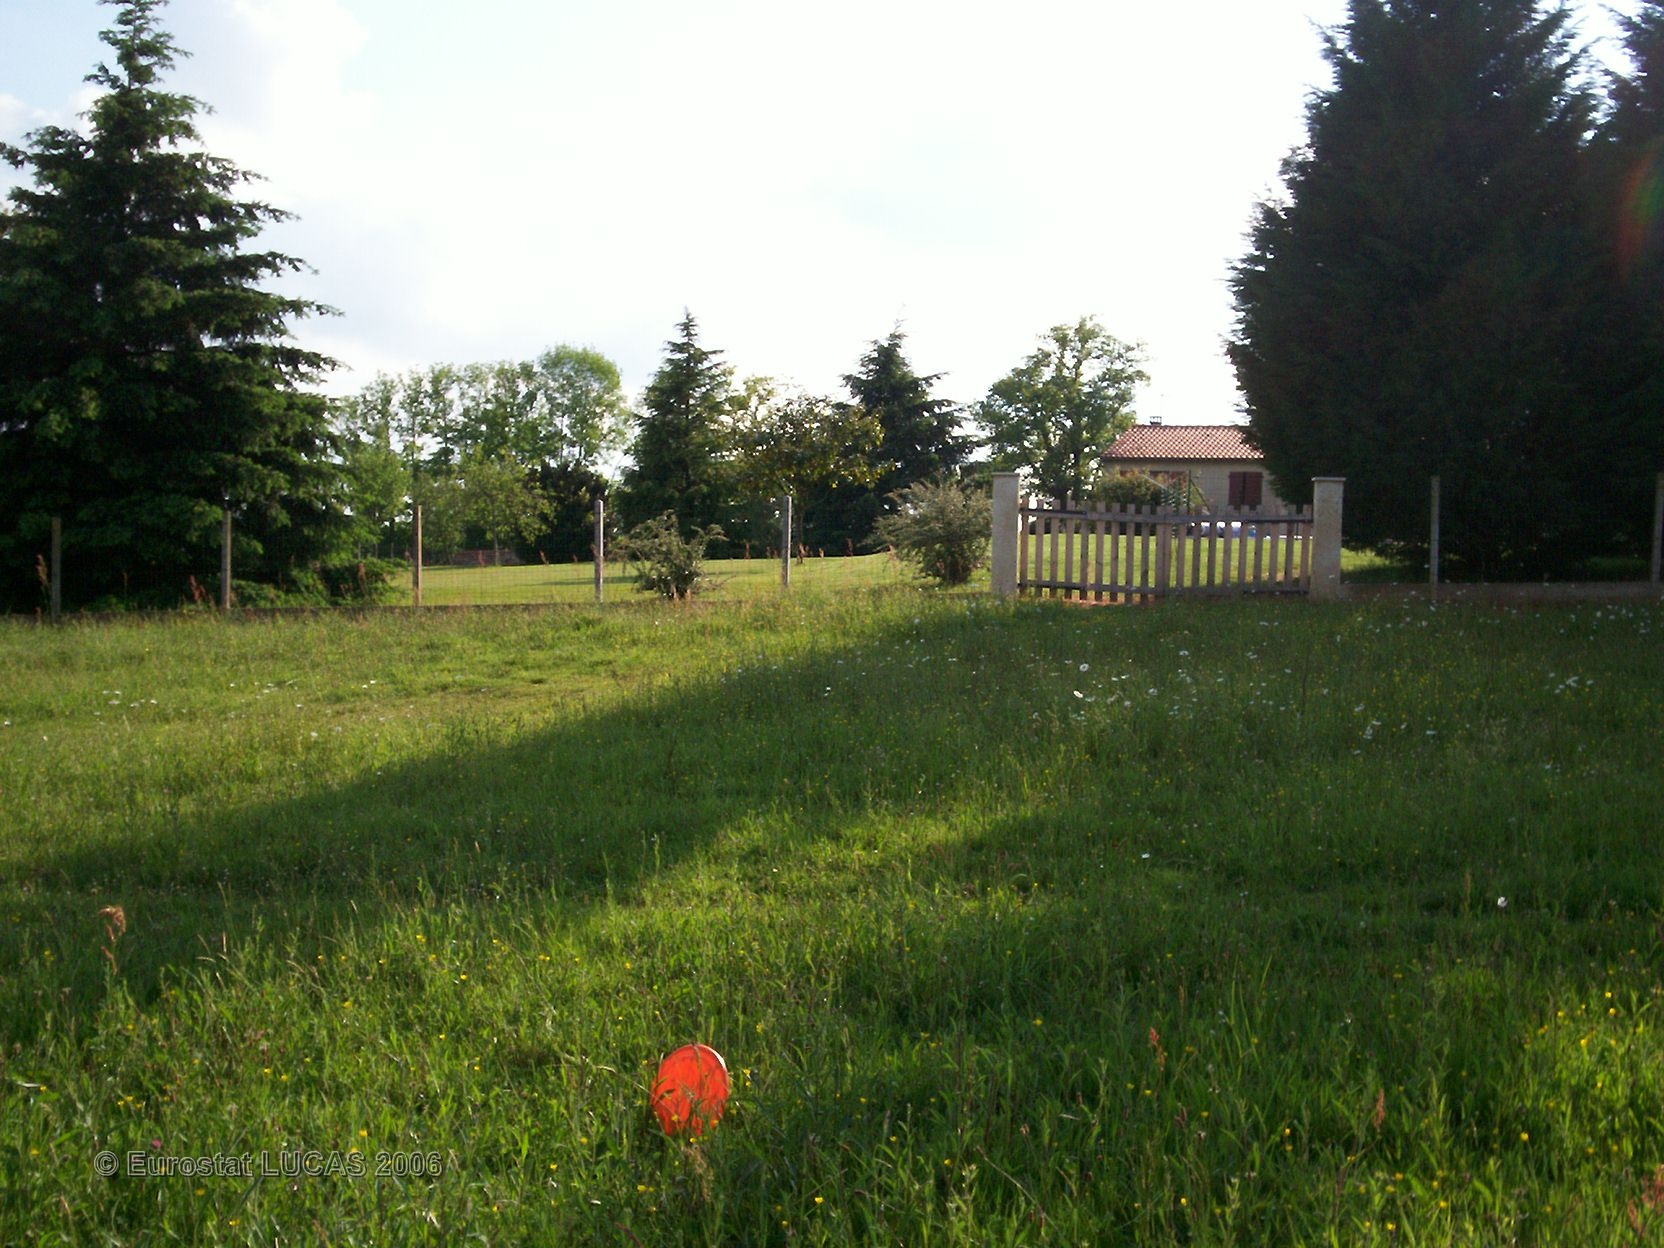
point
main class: Grassland
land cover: Grassland without tree/shrub cover
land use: Agriculture (excluding fallow land and kitchen gardens)
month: May
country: FR
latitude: 45.7093
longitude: 0.4933
